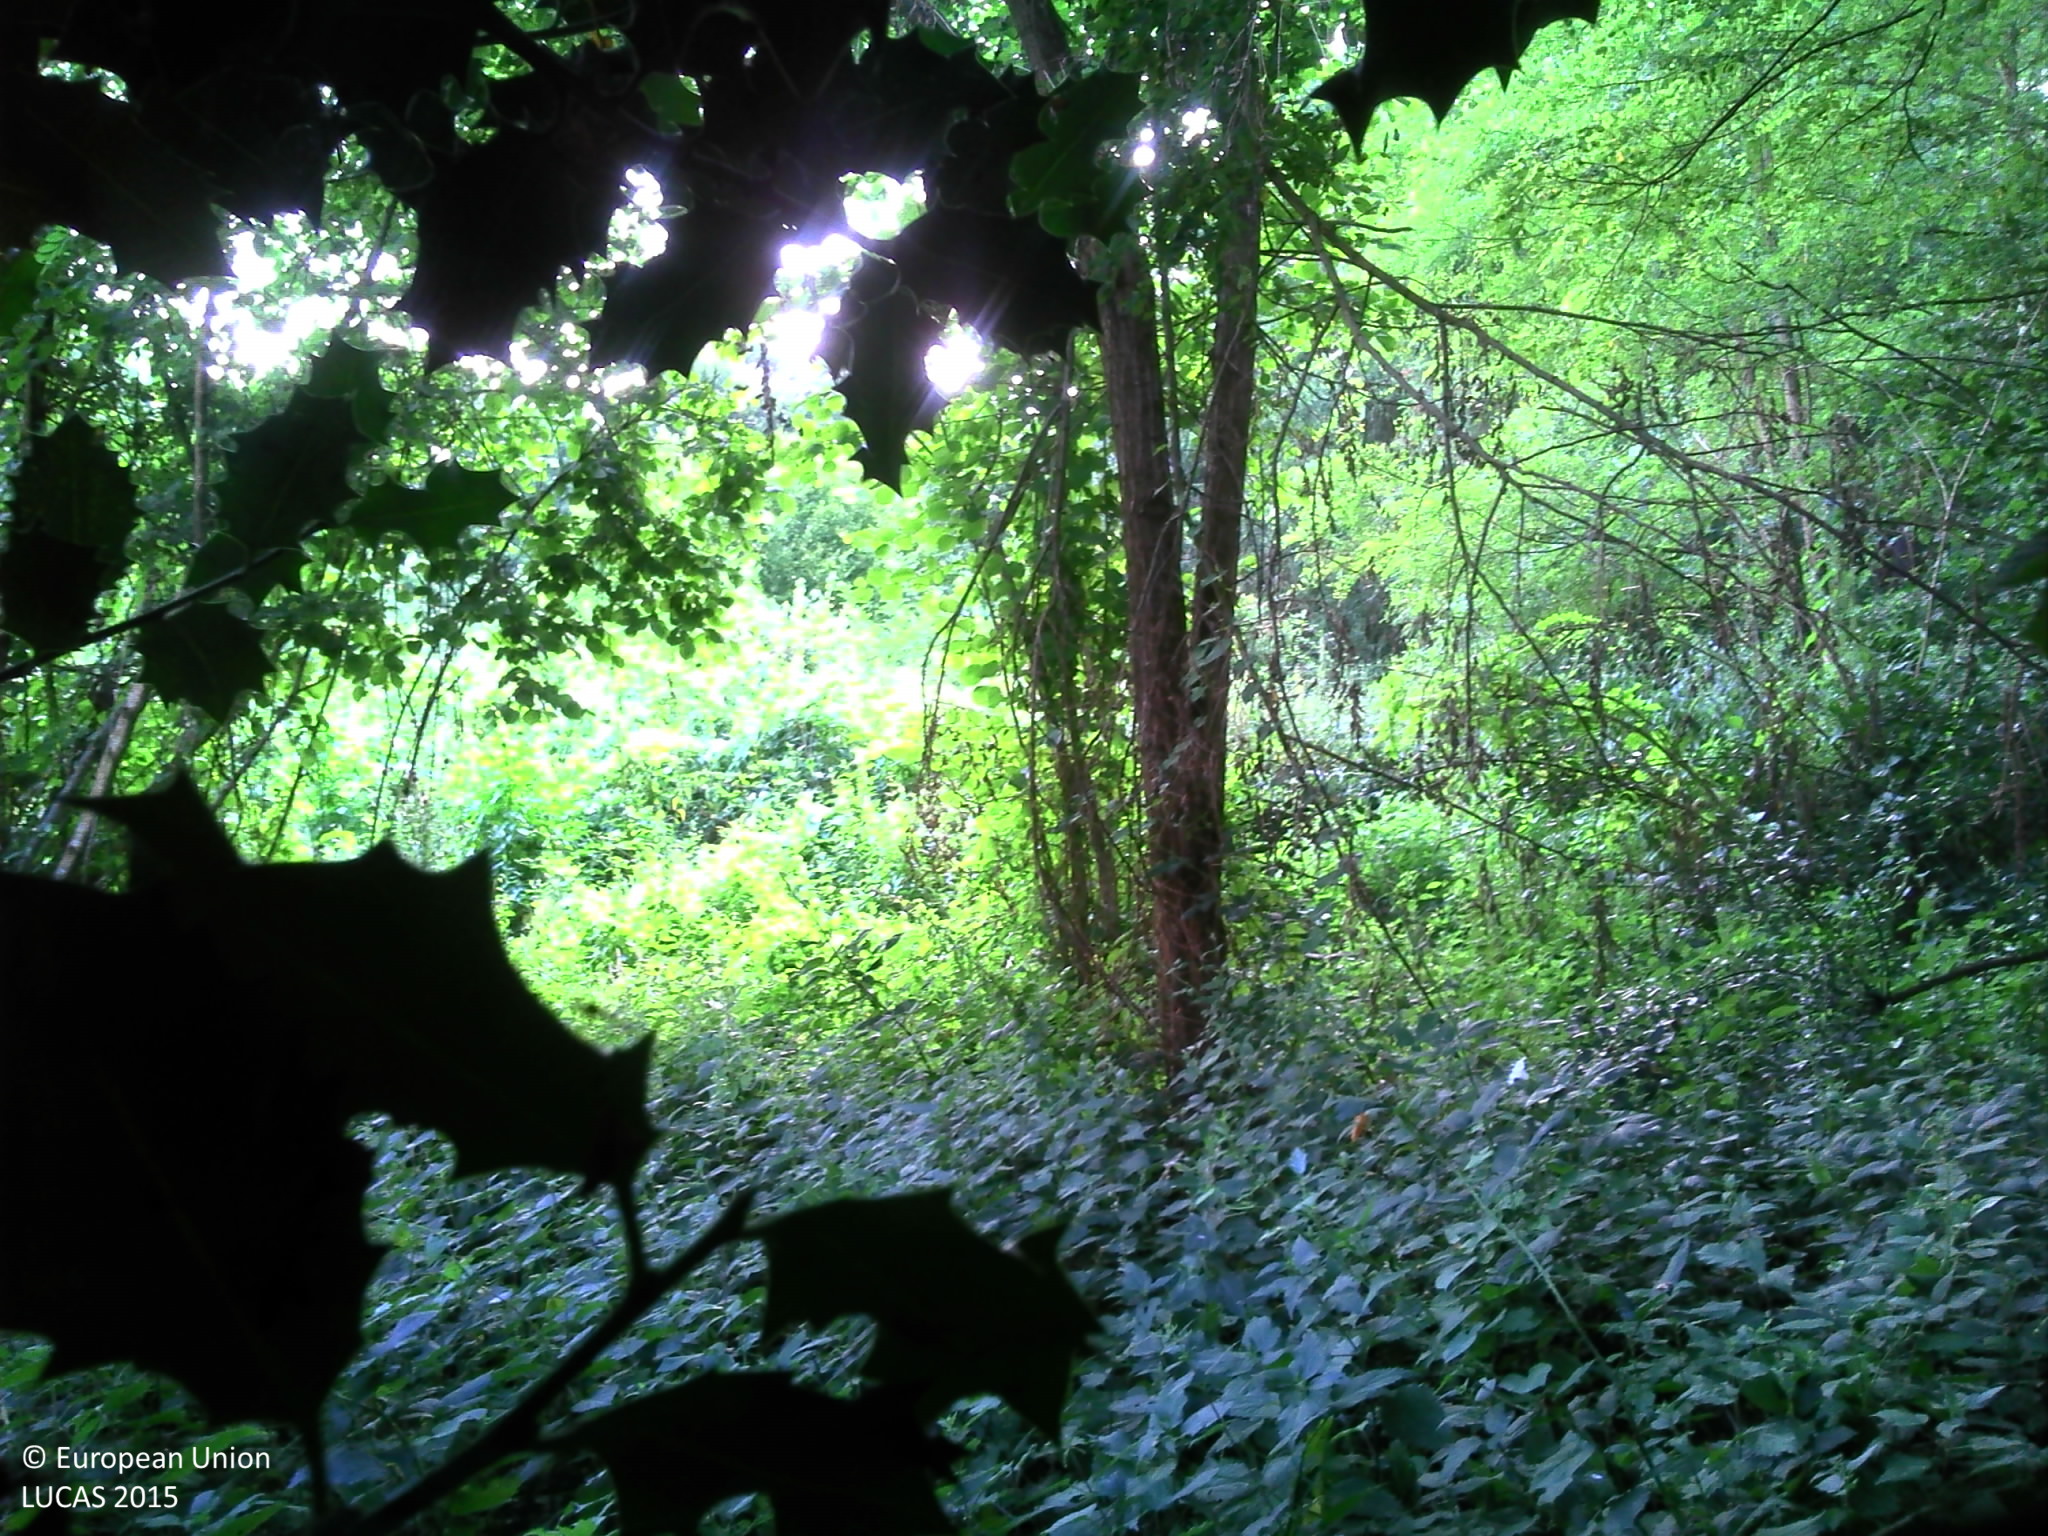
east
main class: Woodland
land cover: Broadleaved woodland
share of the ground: > 75 %
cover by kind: broadleaved forest trees 90 %, herbaceous plants 10 %
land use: Residential
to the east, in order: Broadleaved woodland; Shrubland without tree cover; Single bushes/trees; Artificial constructions in urban areas; Maize; Broadleaved woodland; Fences; Grassland with sparse tree/shrub cover; Artificial constructions in urban areas; Broadleaved woodland; Artificial constructions in urban areas; Broadleaved woodland
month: July
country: FR
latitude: 47.5180
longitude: -1.9341
